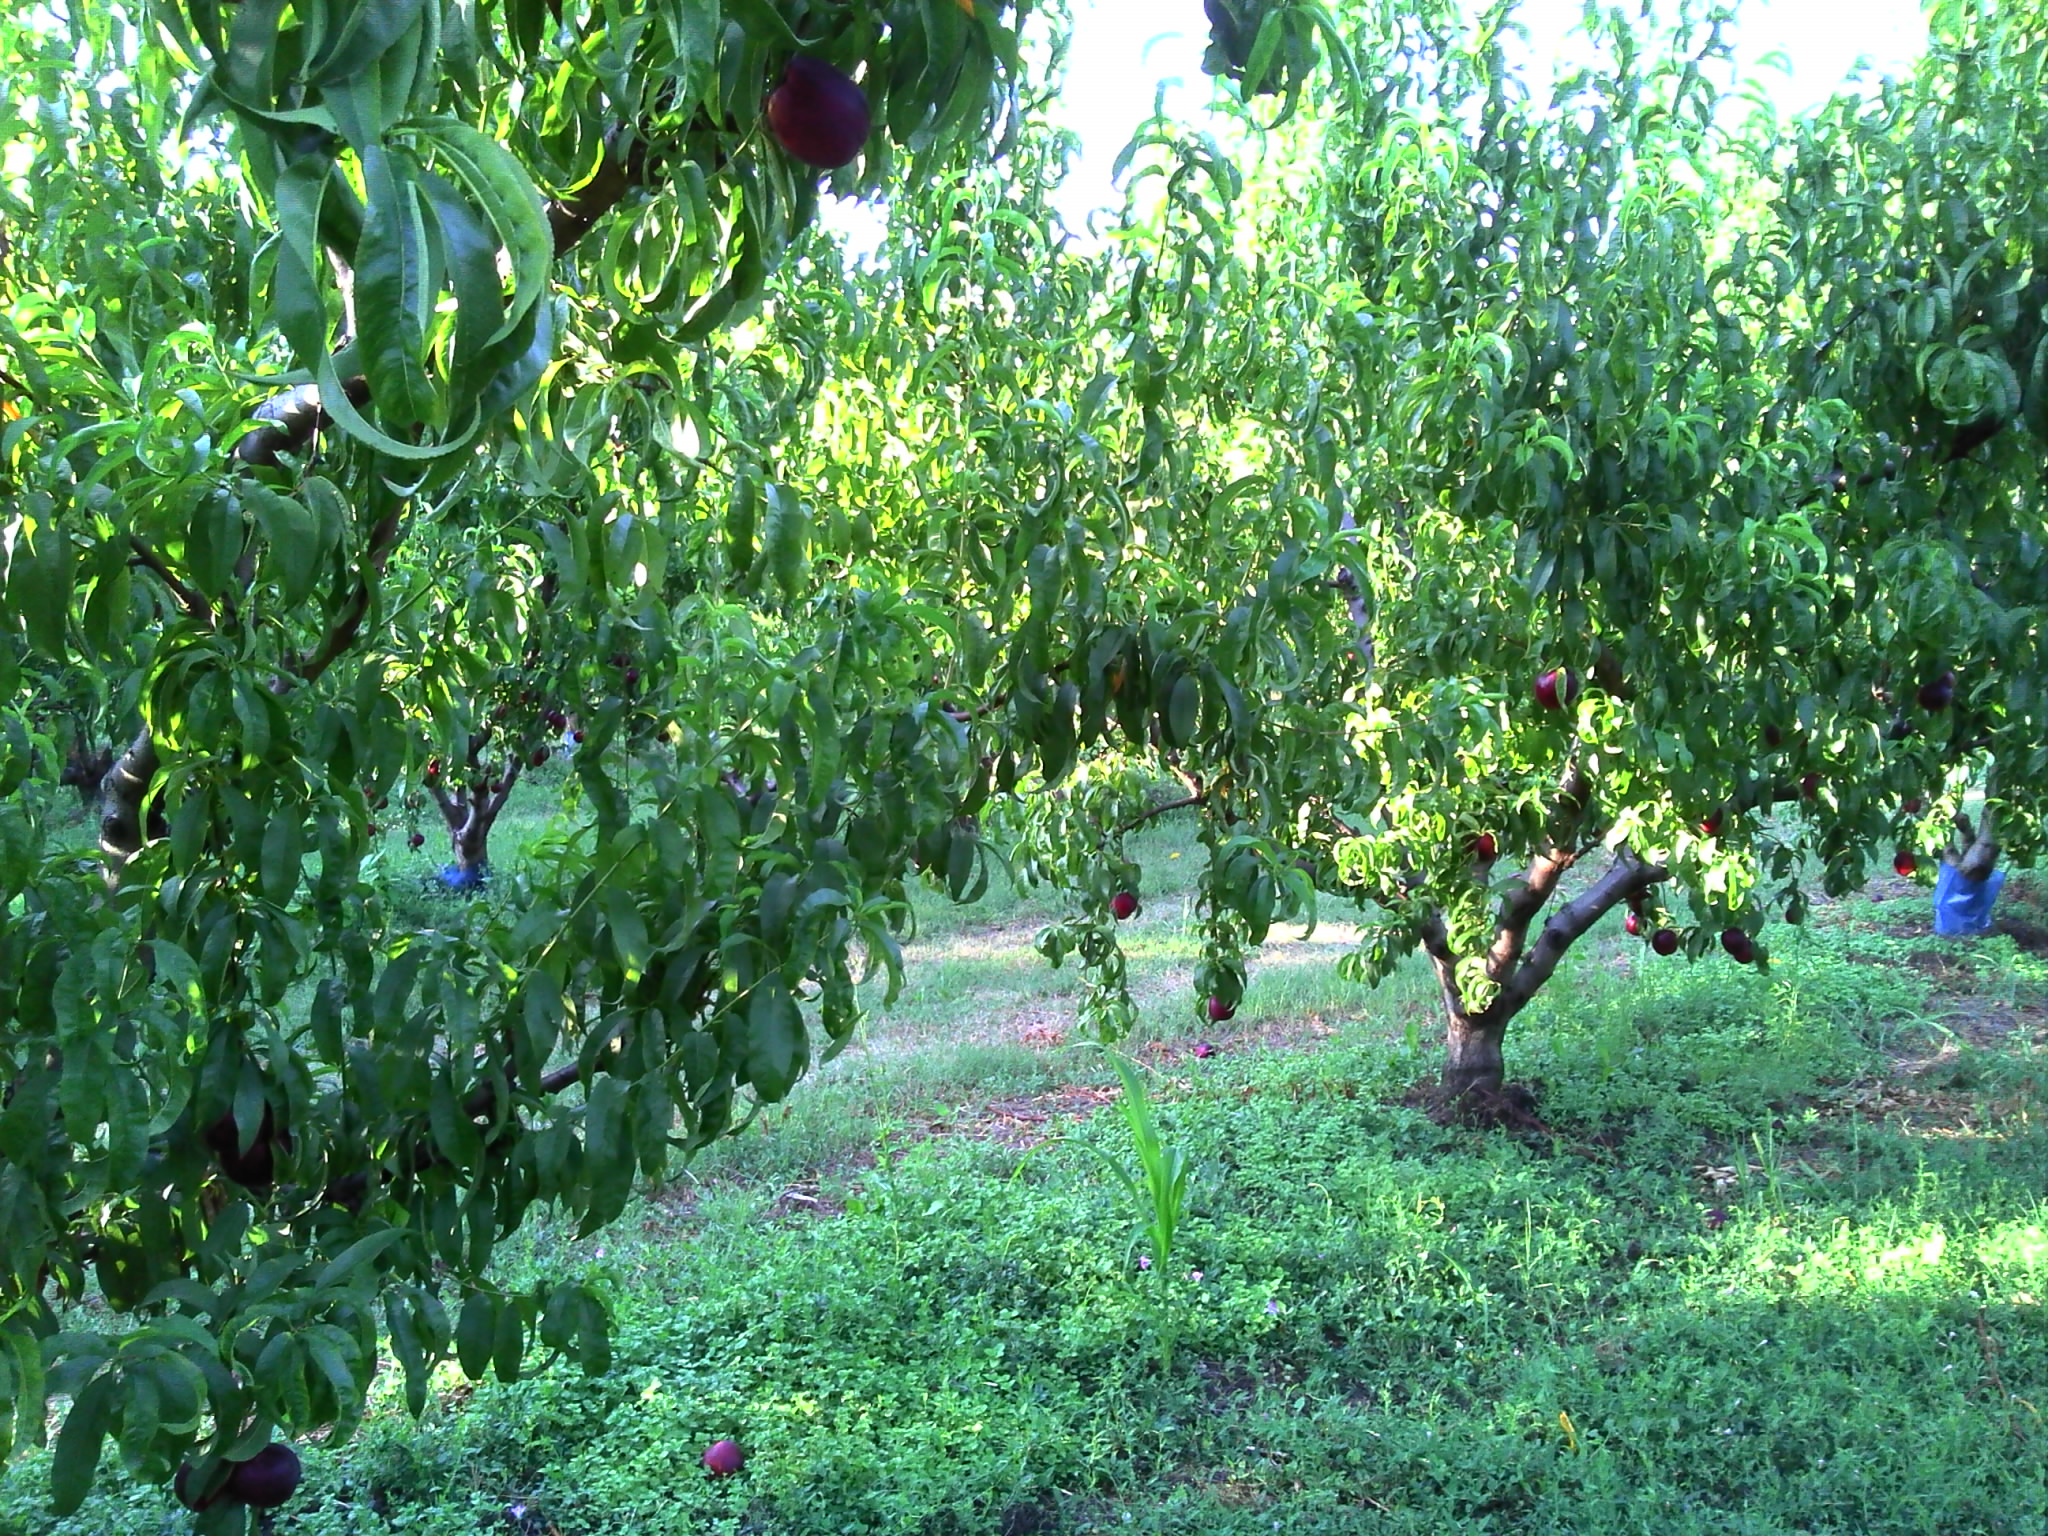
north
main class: Cropland
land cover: Other fruit trees and berries
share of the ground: 50 - 75 %
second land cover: Grassland without tree/shrub cover
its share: 25 - 50 %
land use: Agriculture (excluding fallow land and kitchen gardens)
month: August
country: FR
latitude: 44.2839
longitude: 4.6317
